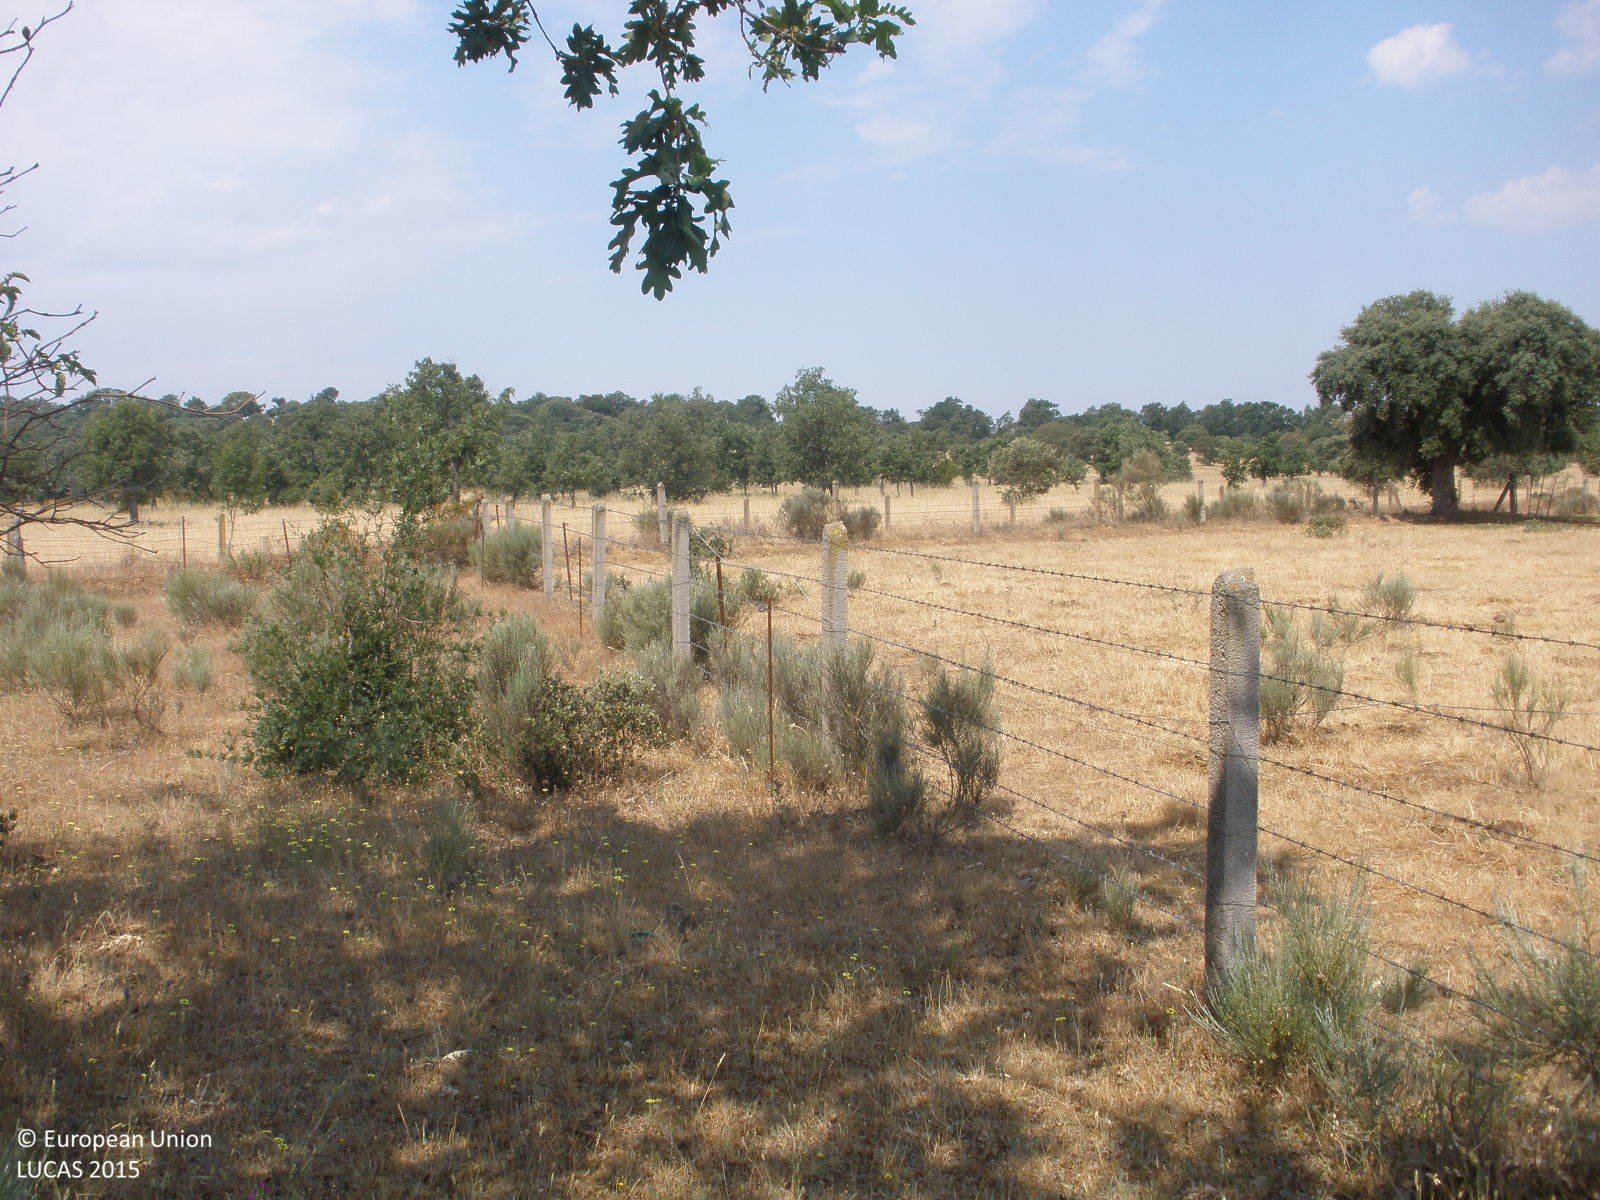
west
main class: Woodland
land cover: Broadleaved woodland
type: thermophilous deciduous forest
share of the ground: > 75 %
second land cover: Grassland without tree/shrub cover
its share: > 75 %
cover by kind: broadleaved forest trees 60 %, herbaceous plants 30 %, shrubs 10 %
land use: Forestry
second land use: Agriculture (excluding fallow land and kitchen gardens)
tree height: > 5 m
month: June
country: ES
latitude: 40.6099
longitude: -6.3853
